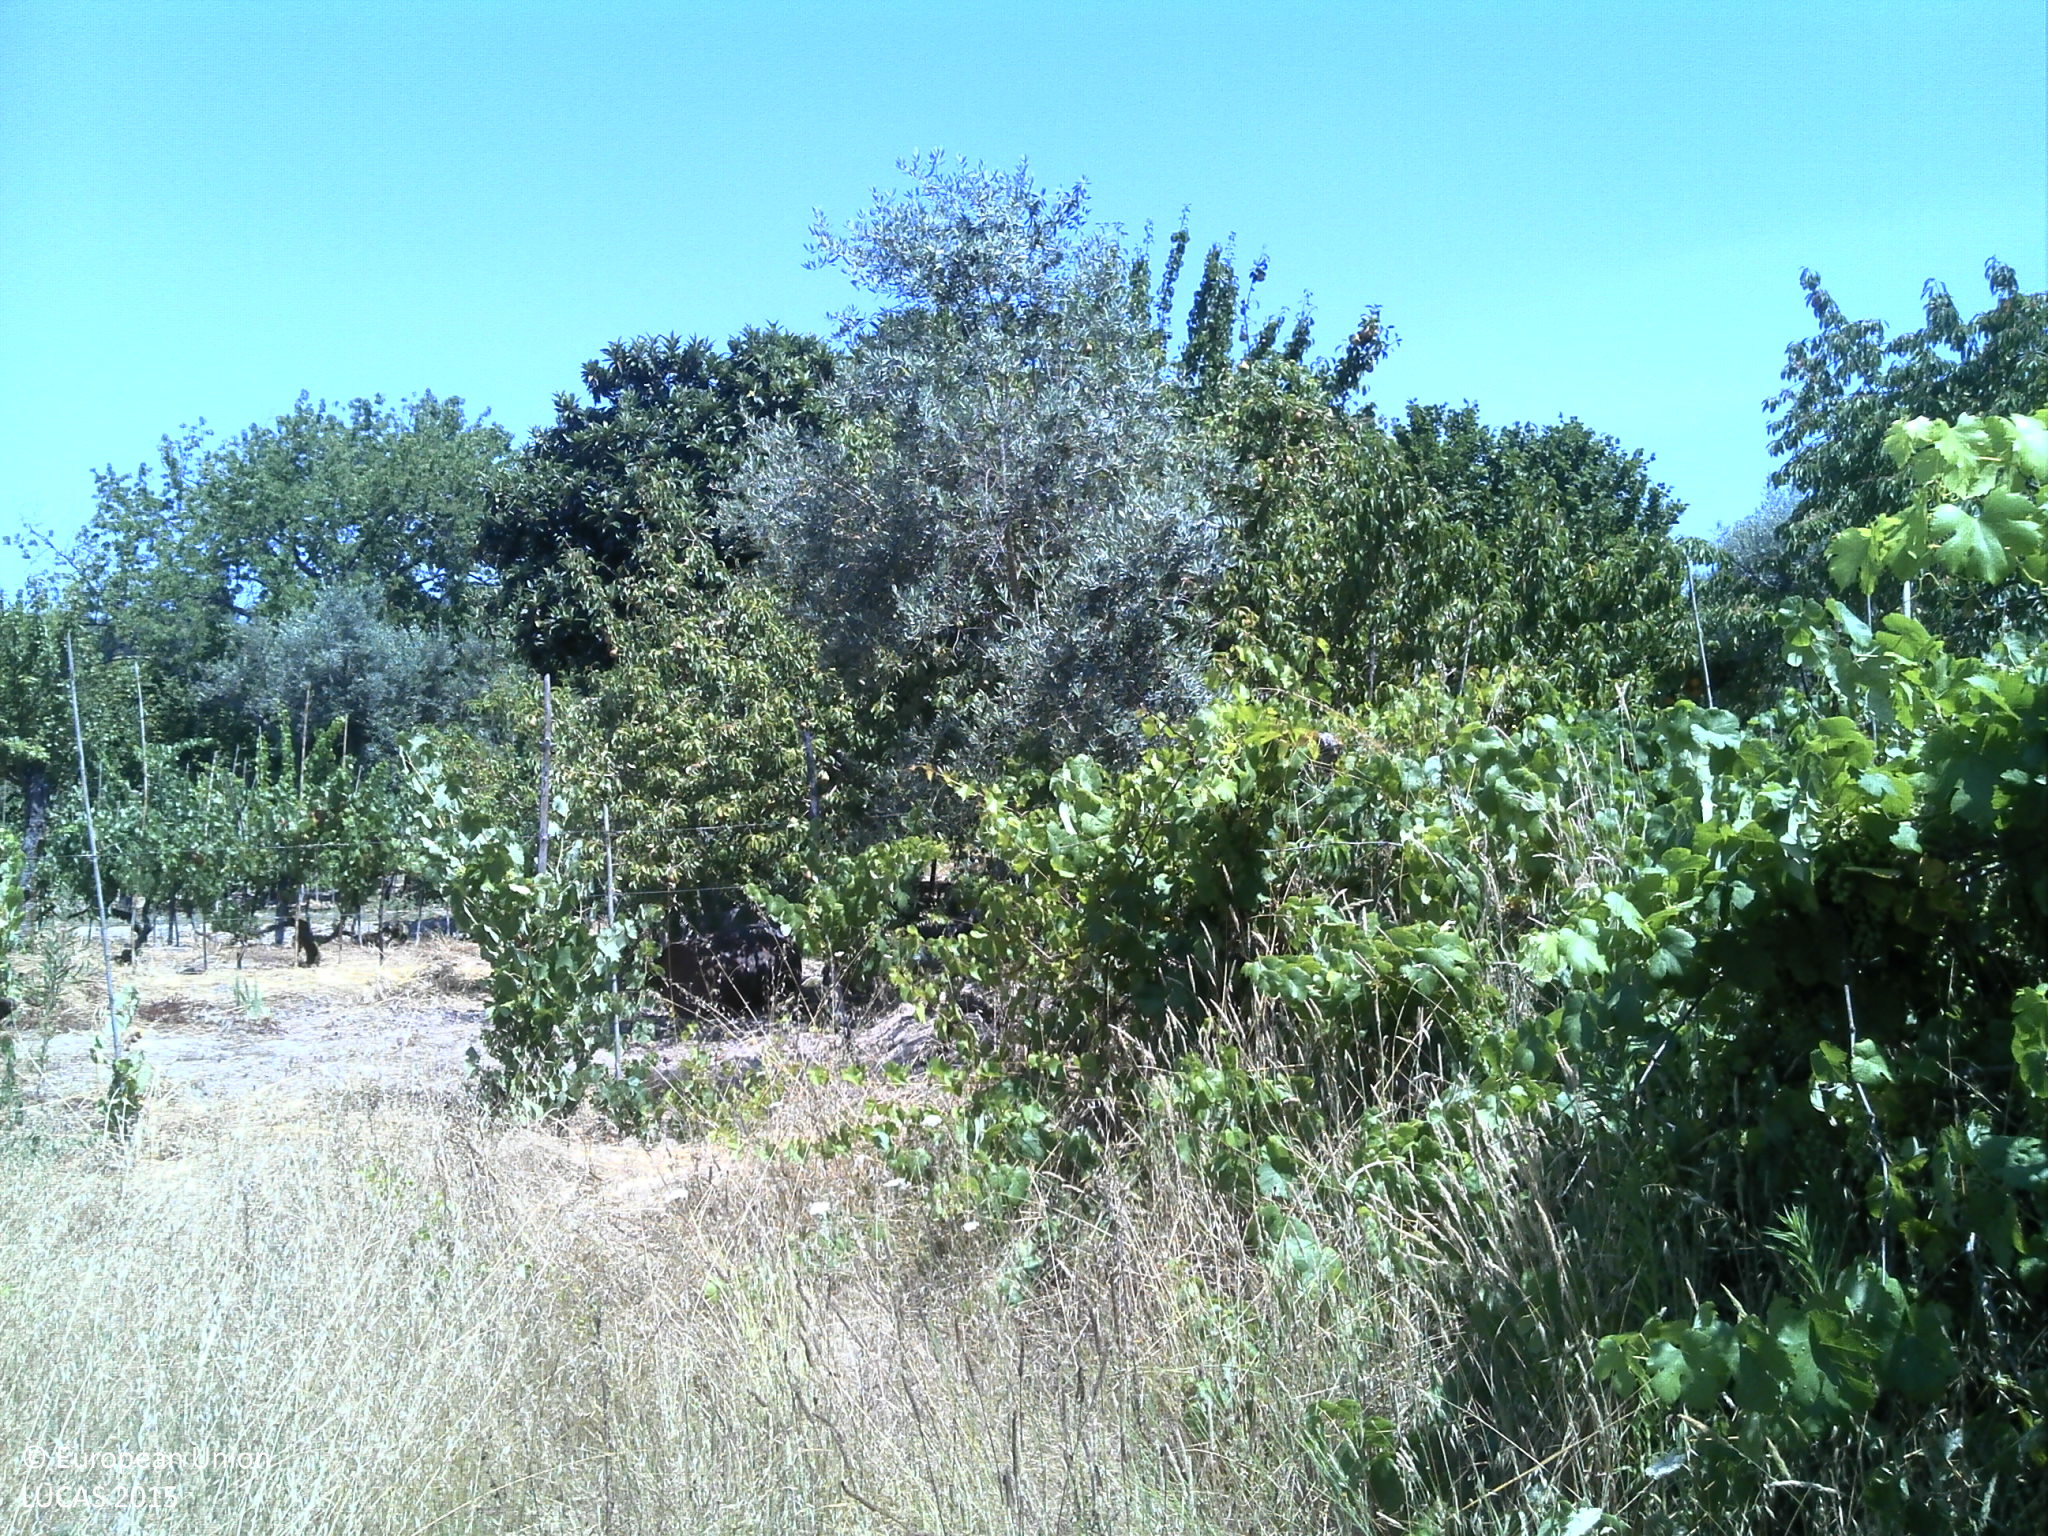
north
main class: Grassland
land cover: Grassland without tree/shrub cover
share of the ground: > 75 %
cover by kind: herbaceous plants 80 %, unconsolidated bare surface 20 %
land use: Agriculture (excluding fallow land and kitchen gardens)
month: July
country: PT
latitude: 40.4730
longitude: -7.9928
